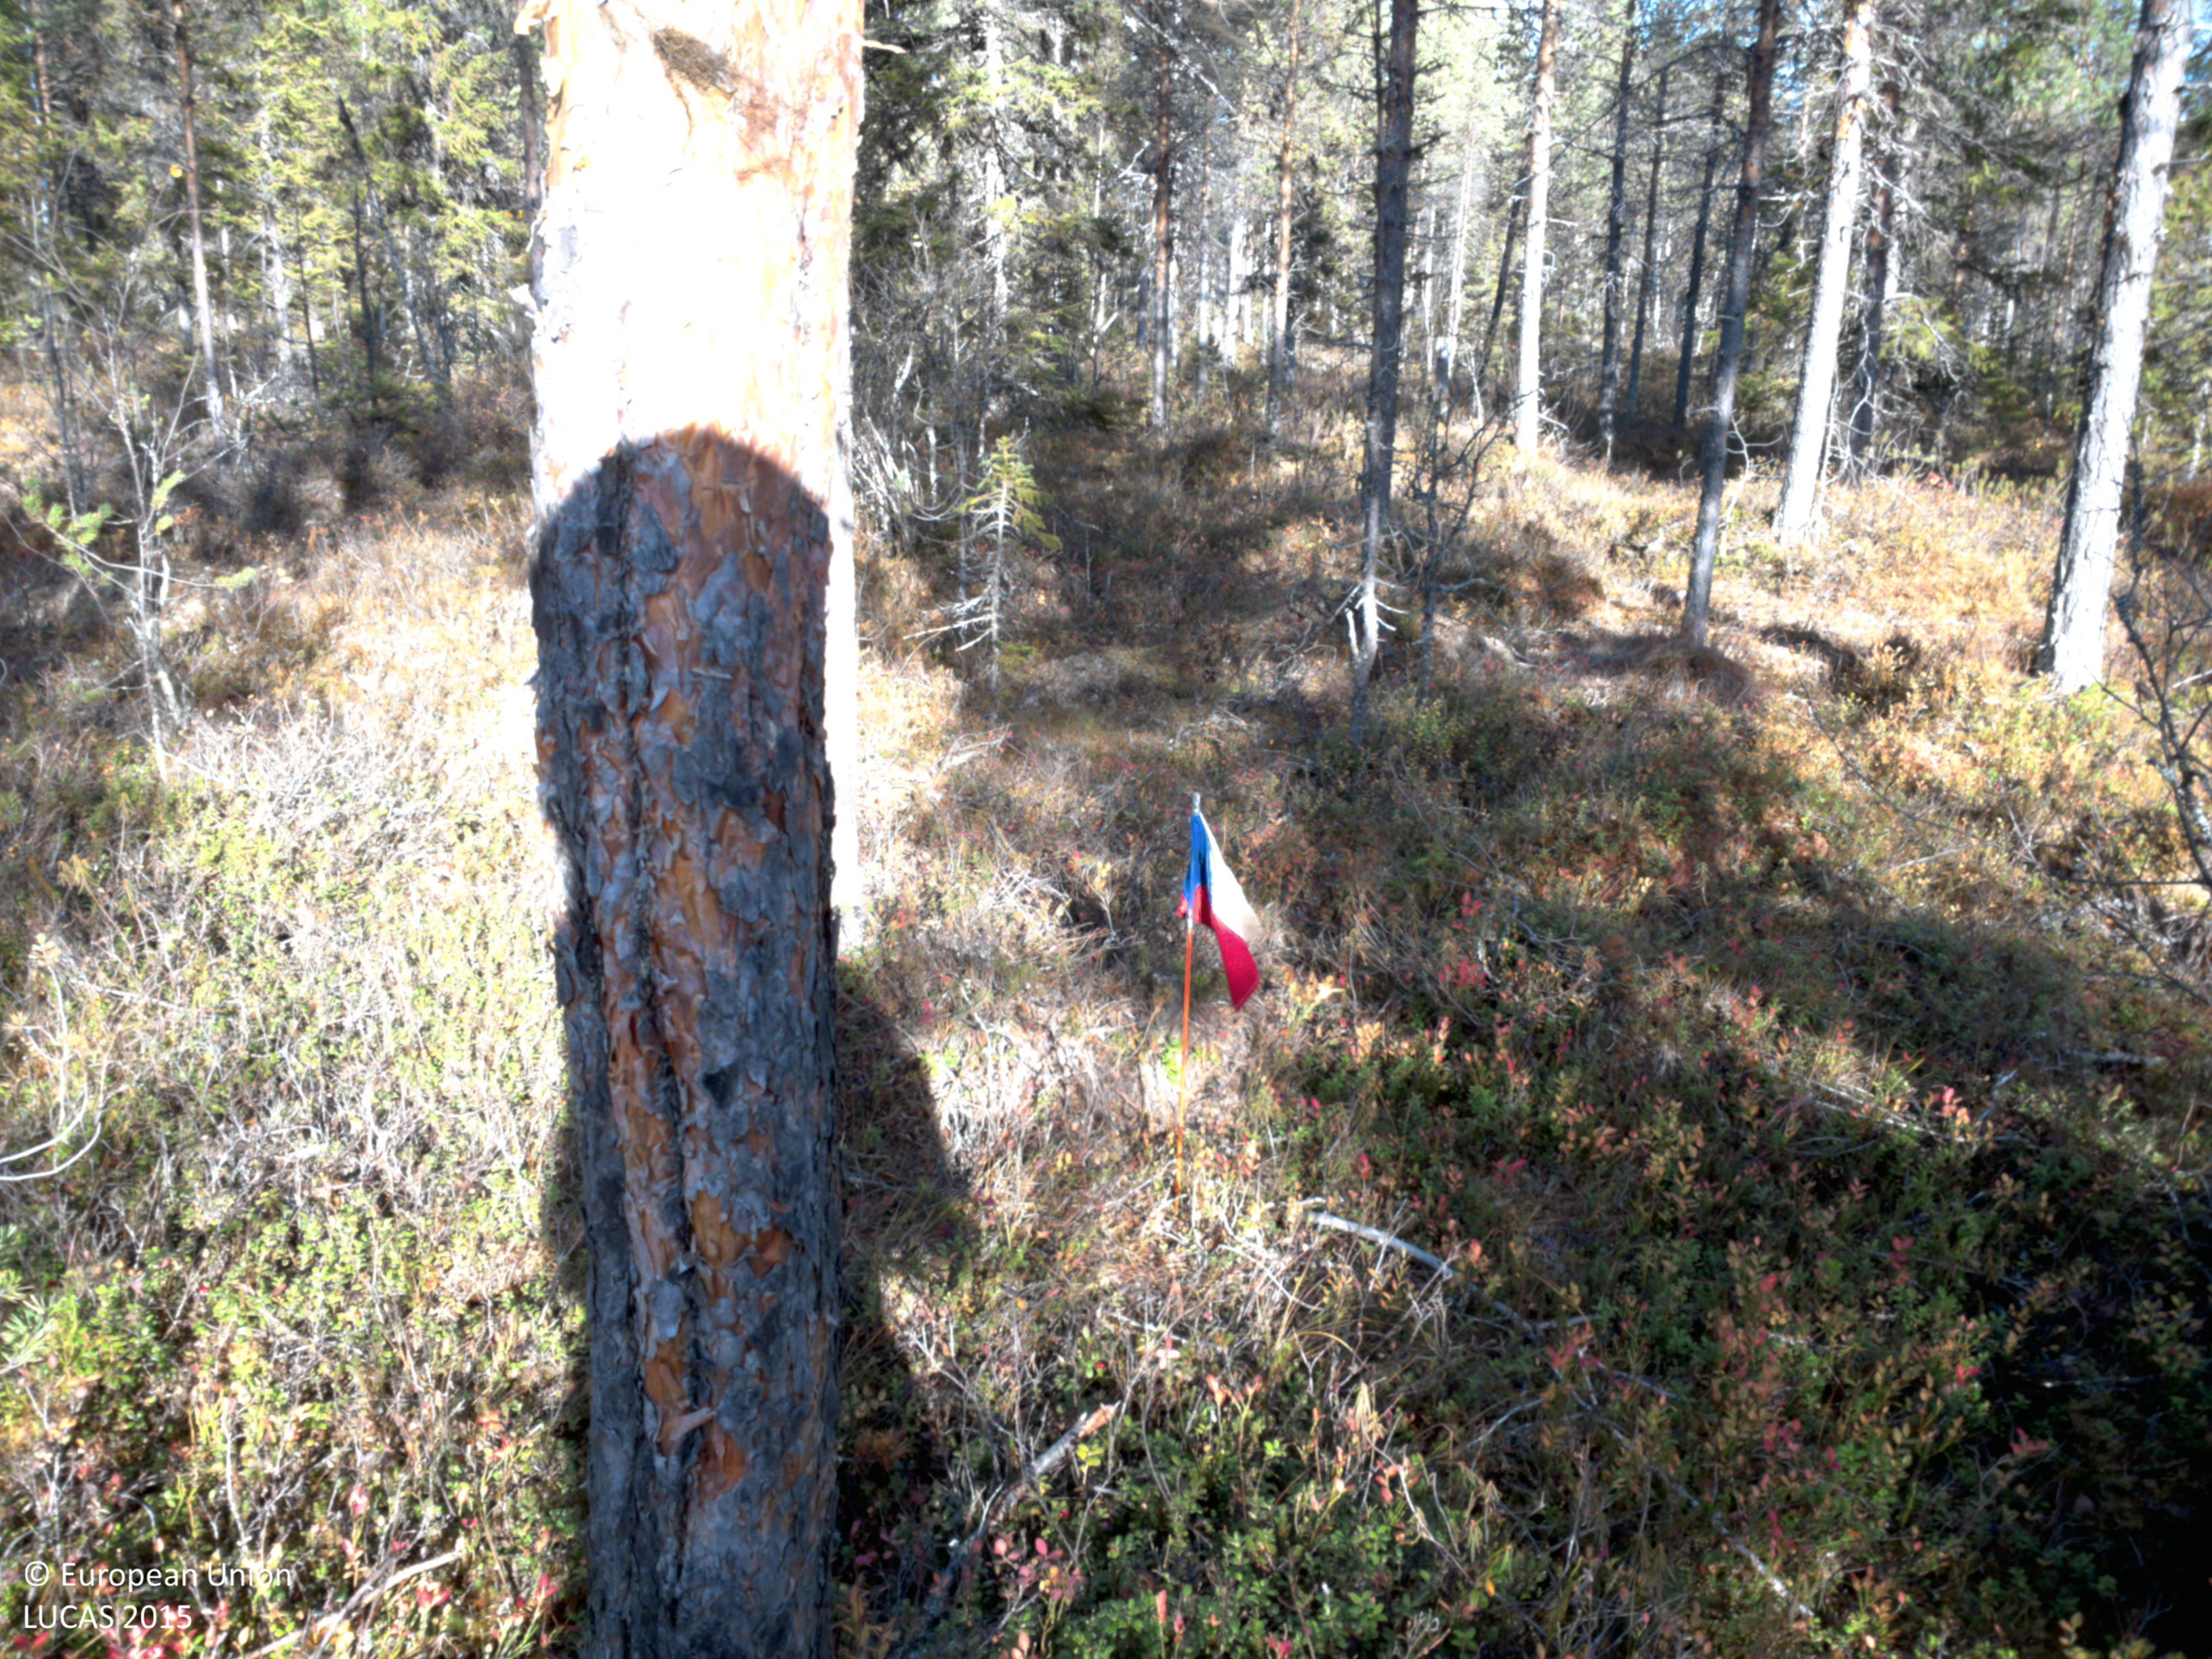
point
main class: Woodland
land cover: Pine dominated coniferous woodland
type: mire and swamp forests
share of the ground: 50 - 75 %
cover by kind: coniferous forest trees 75 %, shrubs 15 %, lichens and mosses 10 %
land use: Forestry
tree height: > 5 m
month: October
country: SE
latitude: 64.8957
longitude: 18.1821
